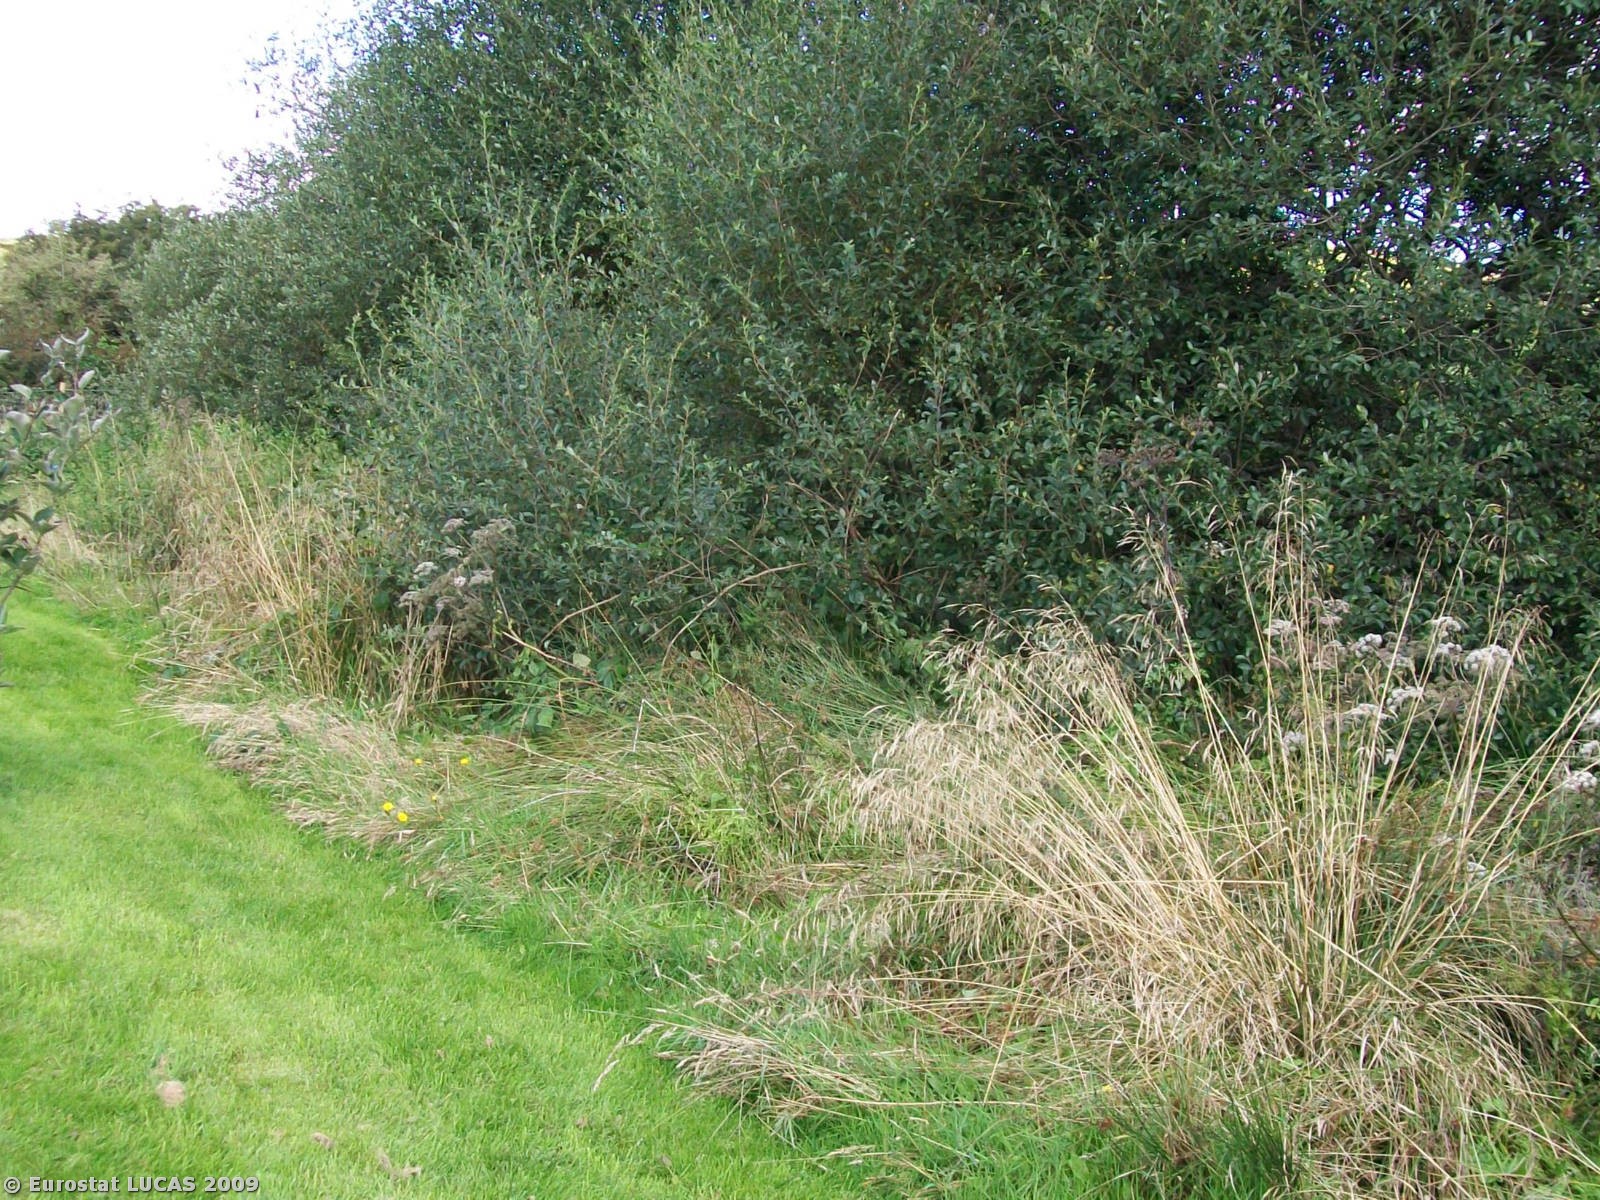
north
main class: Grassland
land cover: Grassland with sparse tree/shrub cover
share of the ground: < 10 %
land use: Residential
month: August
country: GB
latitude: 55.1087
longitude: -4.1226
